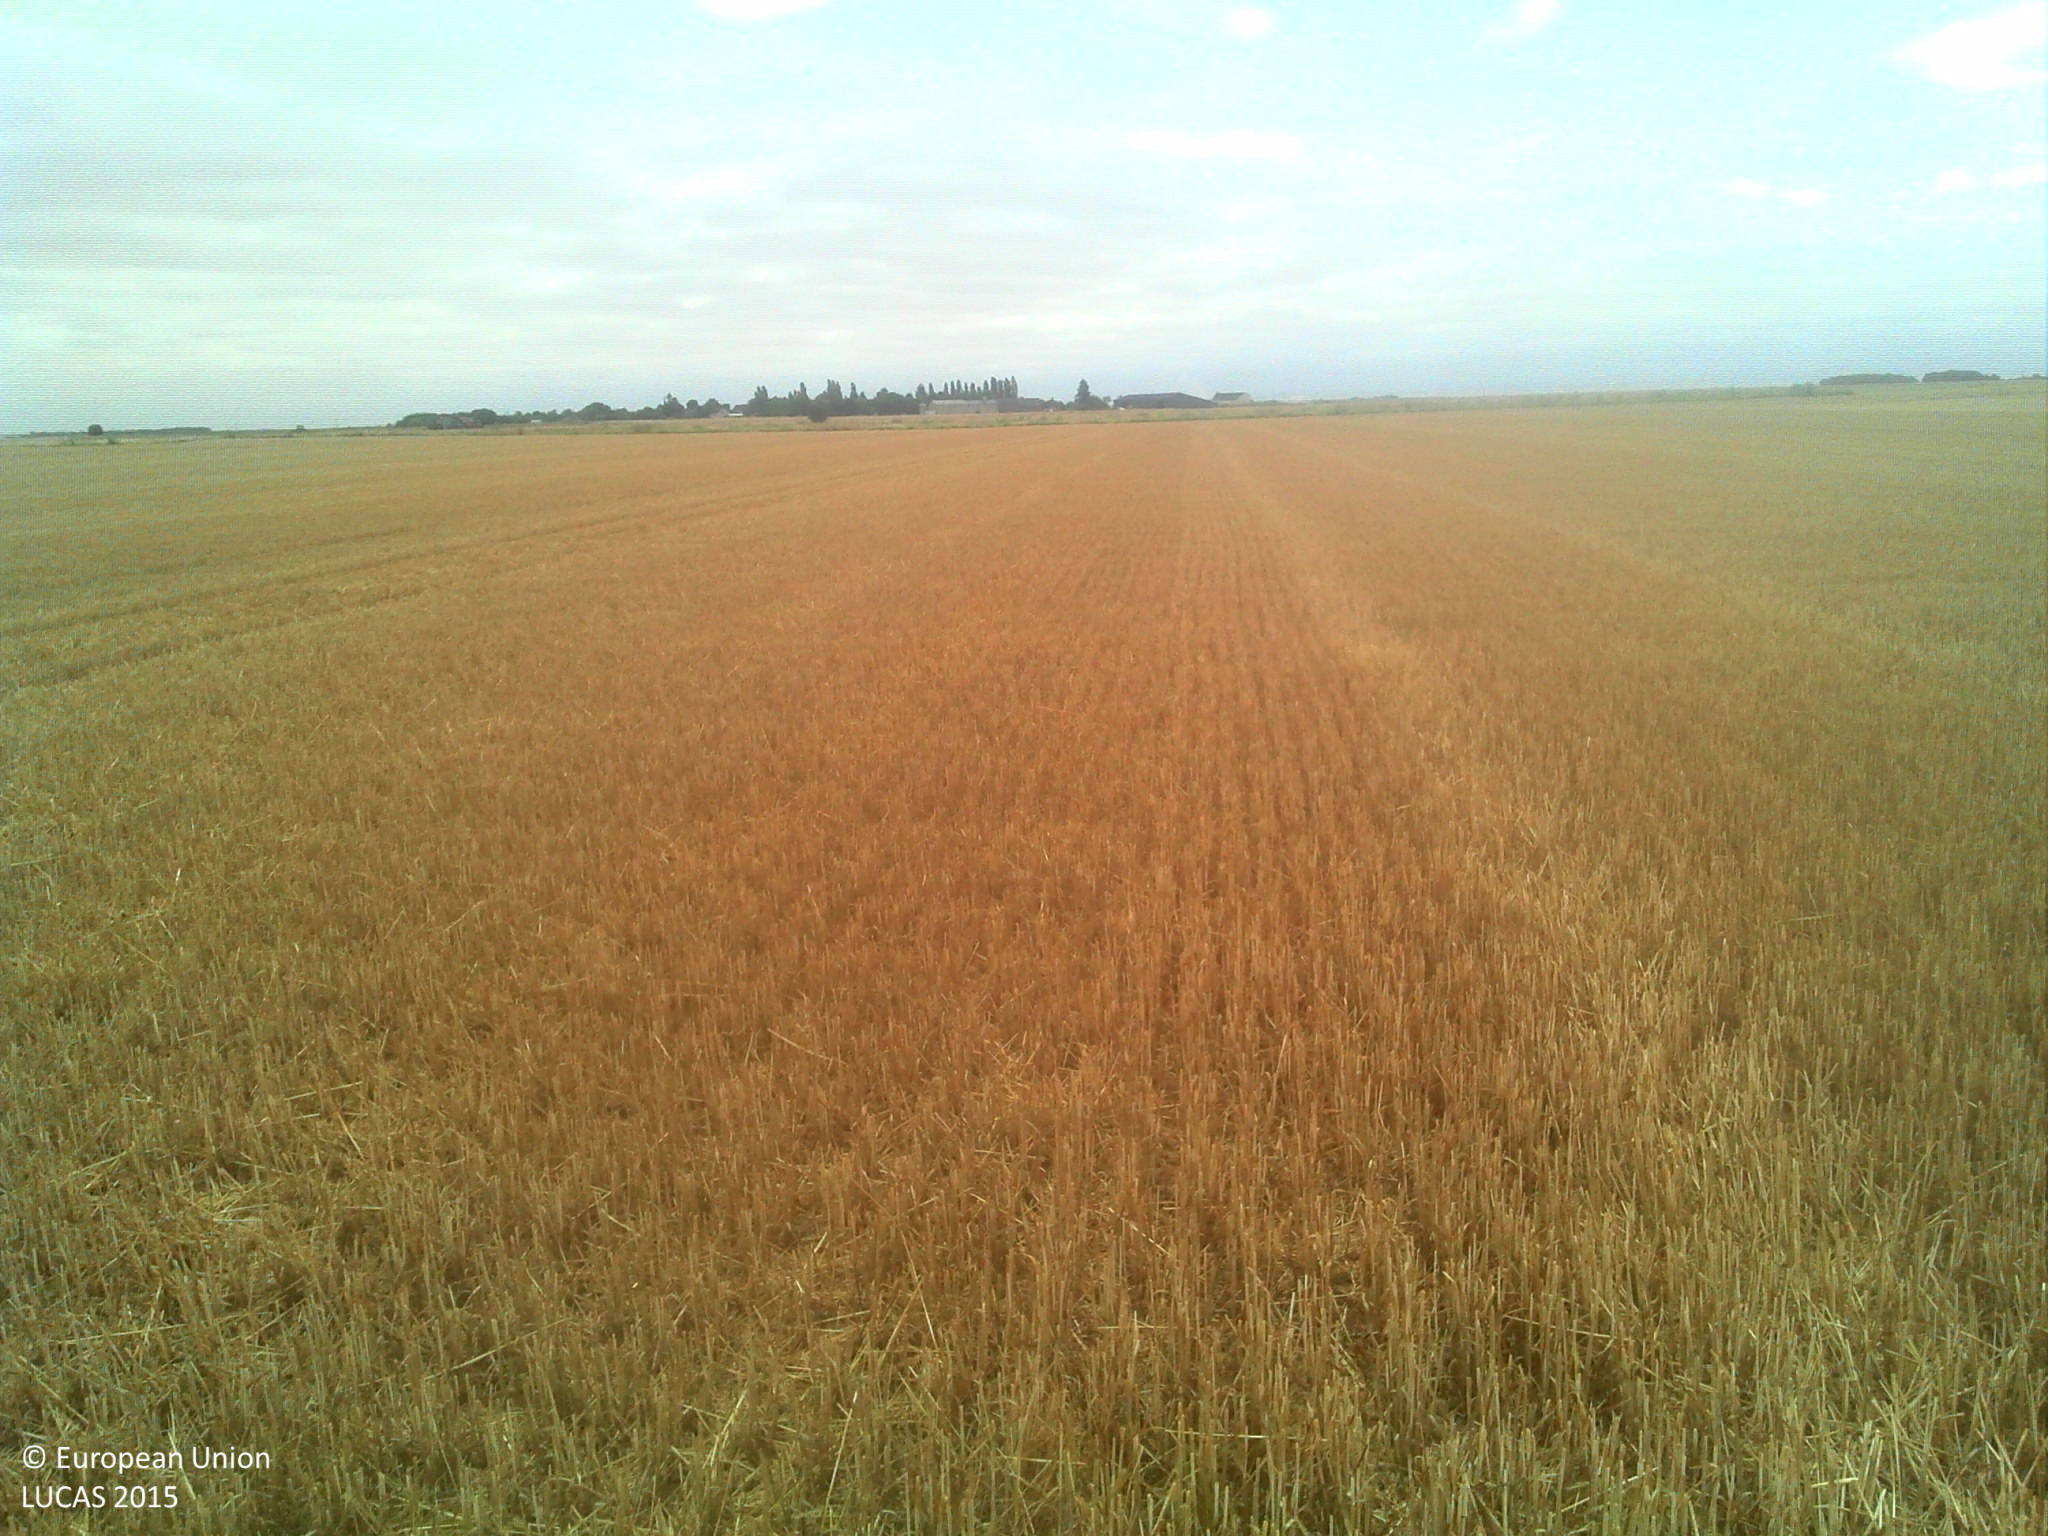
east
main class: Cropland
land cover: Durum wheat
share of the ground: > 75 %
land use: Agriculture (excluding fallow land and kitchen gardens)
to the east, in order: Durum wheat; Spontaneously vegetated surfaces
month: July
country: FR
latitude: 47.7881
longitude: 1.2941
